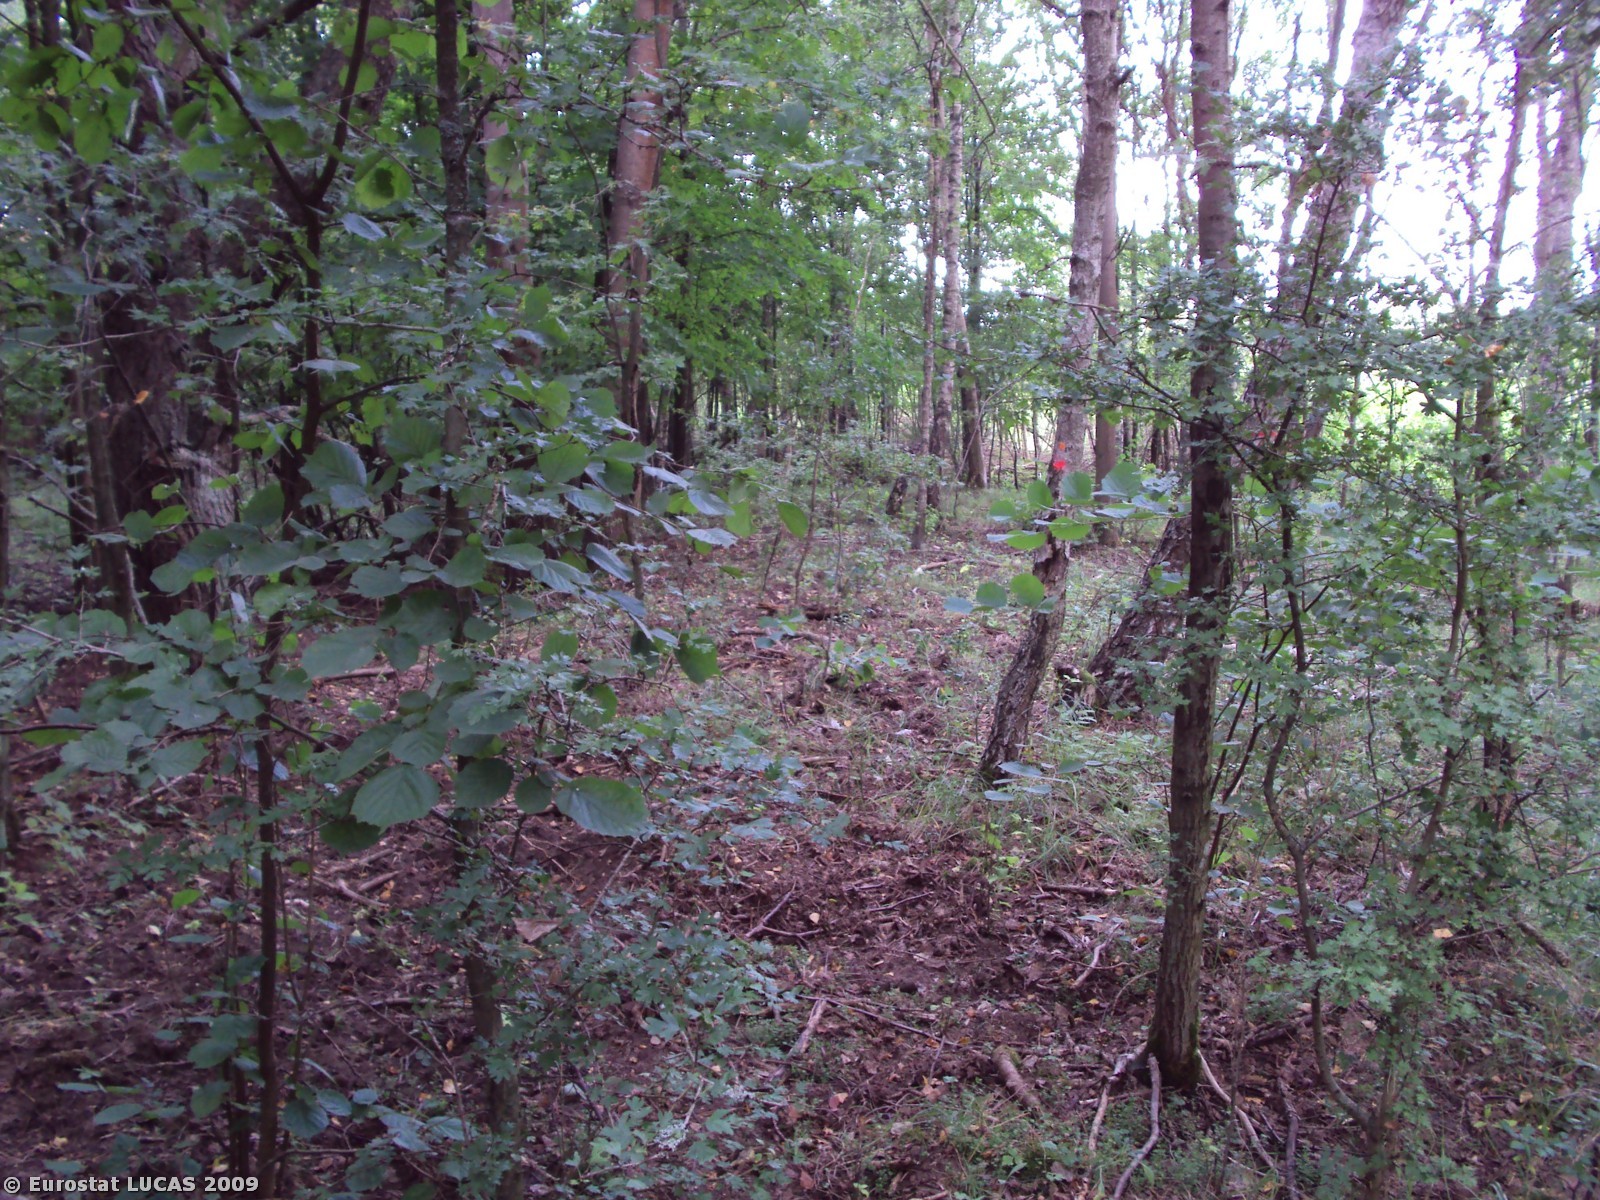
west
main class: Woodland
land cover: Mixed woodland
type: hemiboreal forest and nemoral coniferous forest and mixed broadleaved-coniferous forest
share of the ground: > 75 %
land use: Forestry
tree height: > 5 m
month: August
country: PL
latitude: 53.4928
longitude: 16.5941
